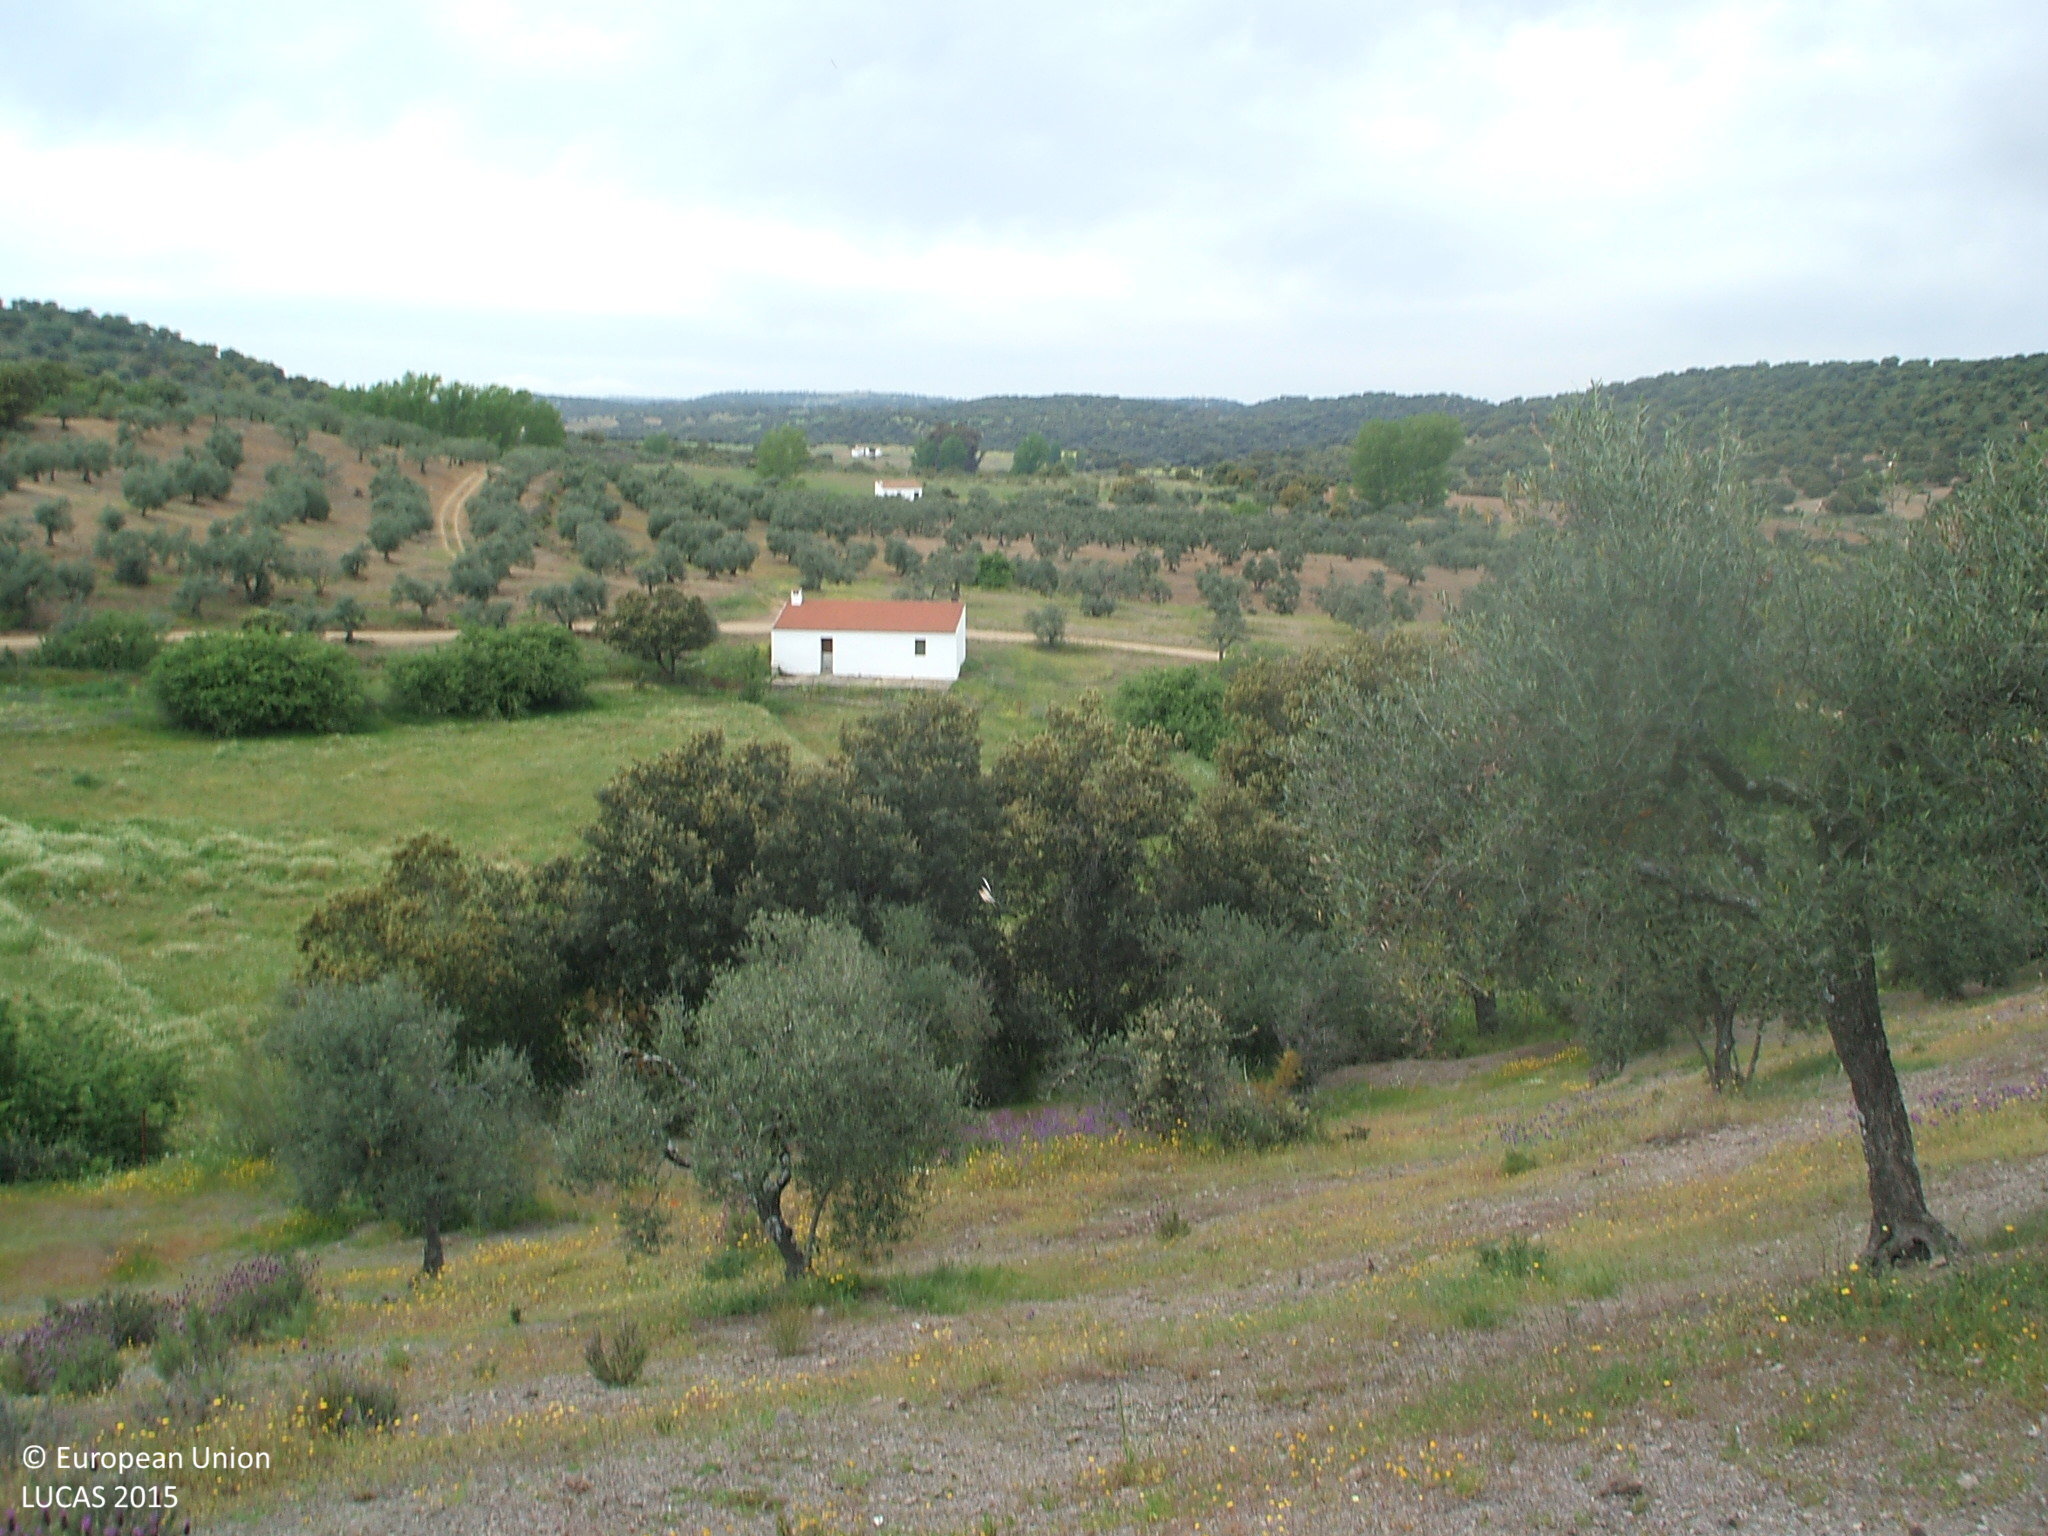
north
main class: Cropland
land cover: Olive groves
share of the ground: 10 - 25 %
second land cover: Shrubland without tree cover
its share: 10 - 25 %
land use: Agriculture (excluding fallow land and kitchen gardens)
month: April
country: ES
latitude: 38.1265
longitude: -5.7181
